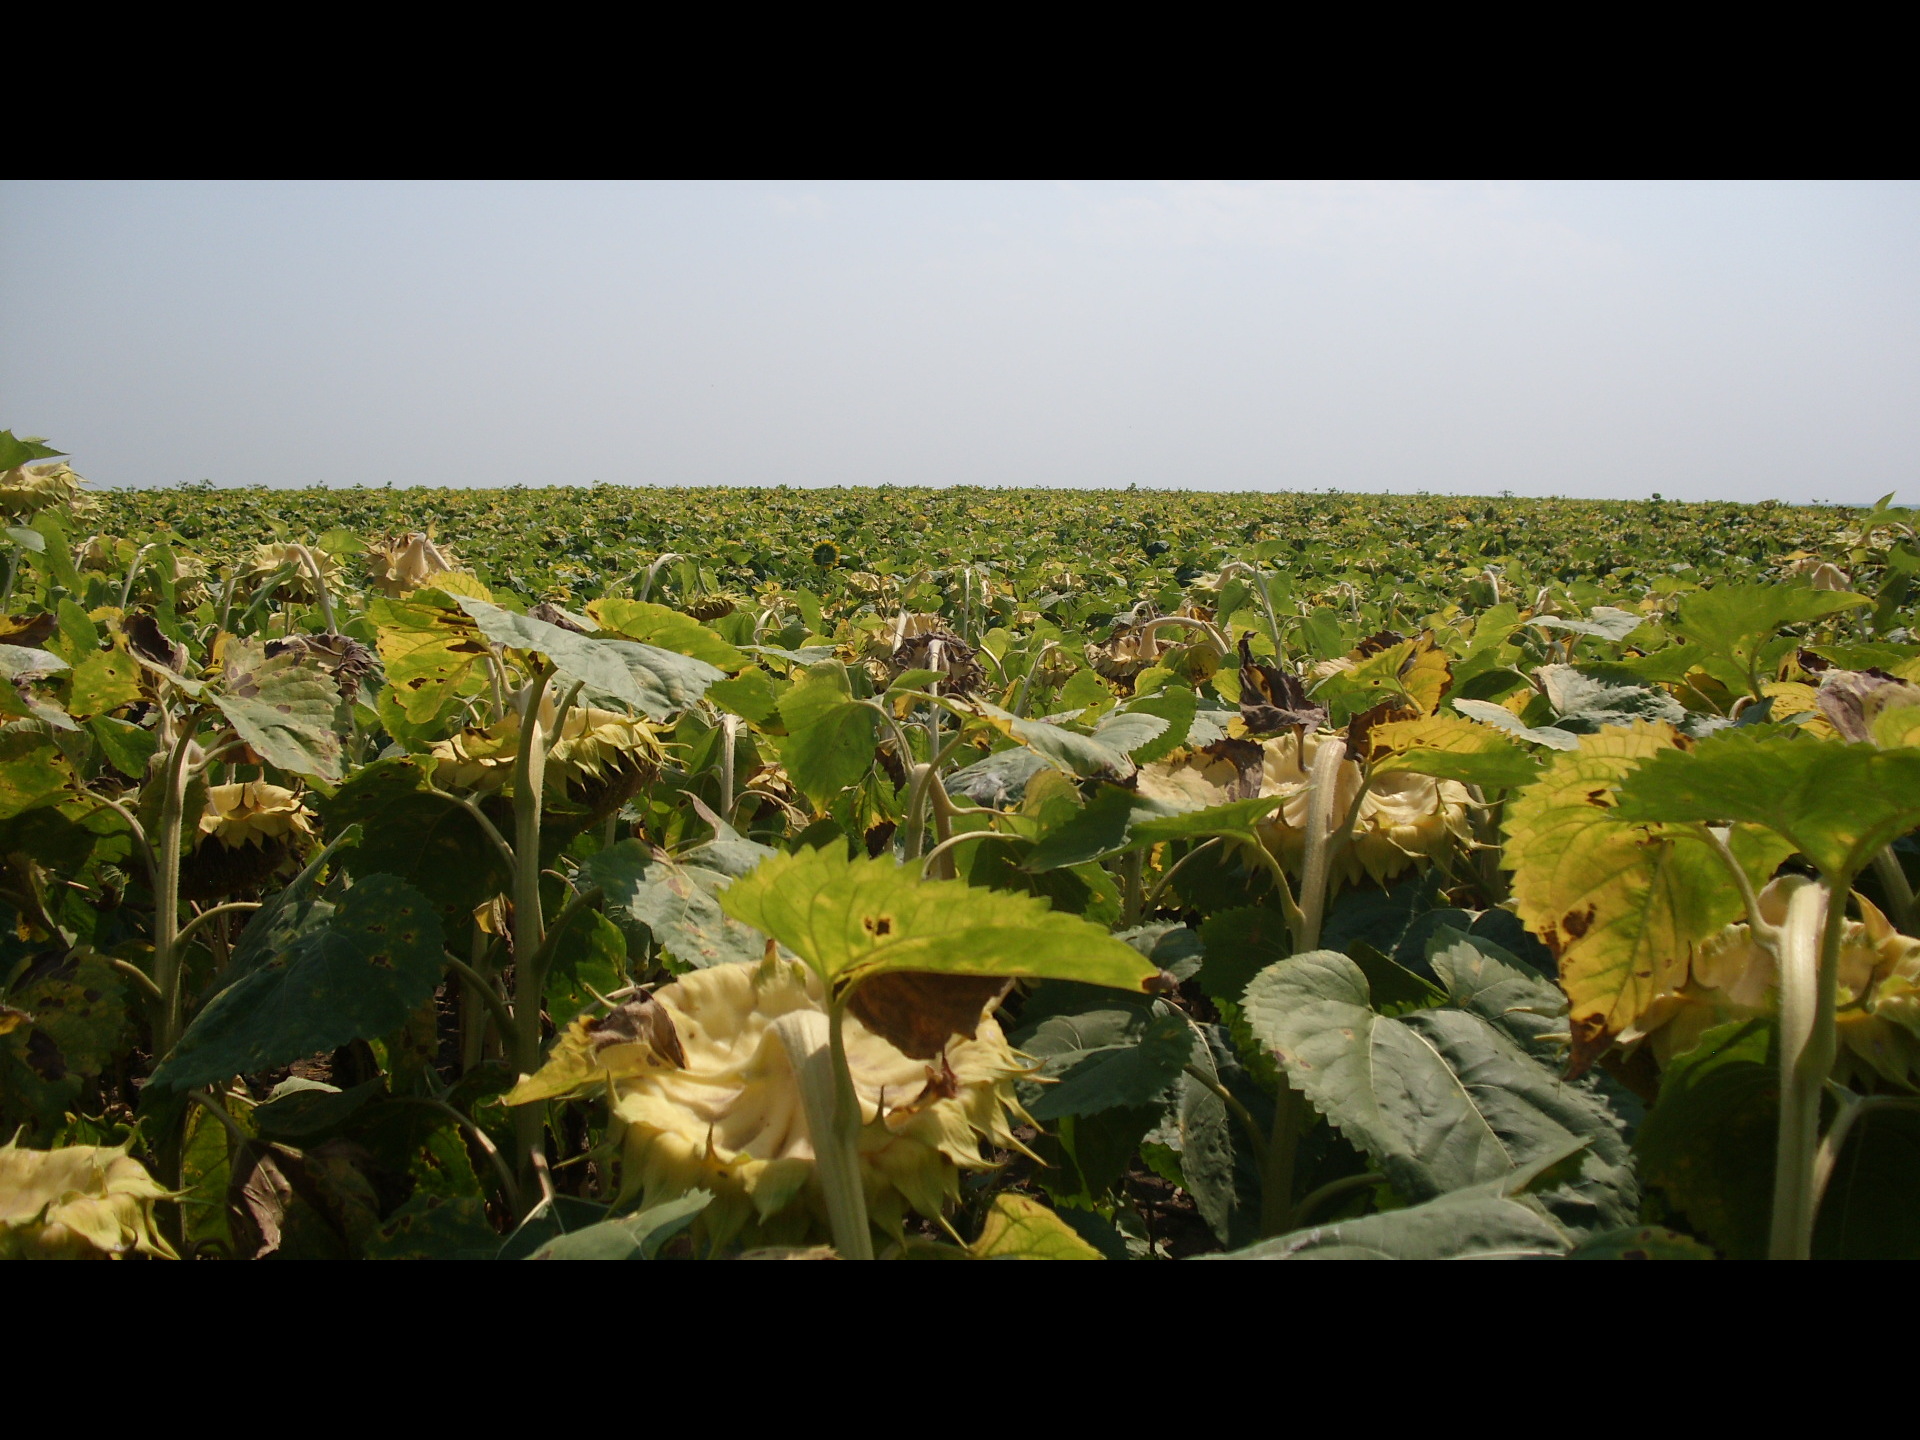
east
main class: Cropland
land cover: Sunflower
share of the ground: > 75 %
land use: Agriculture (excluding fallow land and kitchen gardens)
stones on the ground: < 10 %
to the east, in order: Sunflower
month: July
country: BG
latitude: 43.7531
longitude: 23.5224
